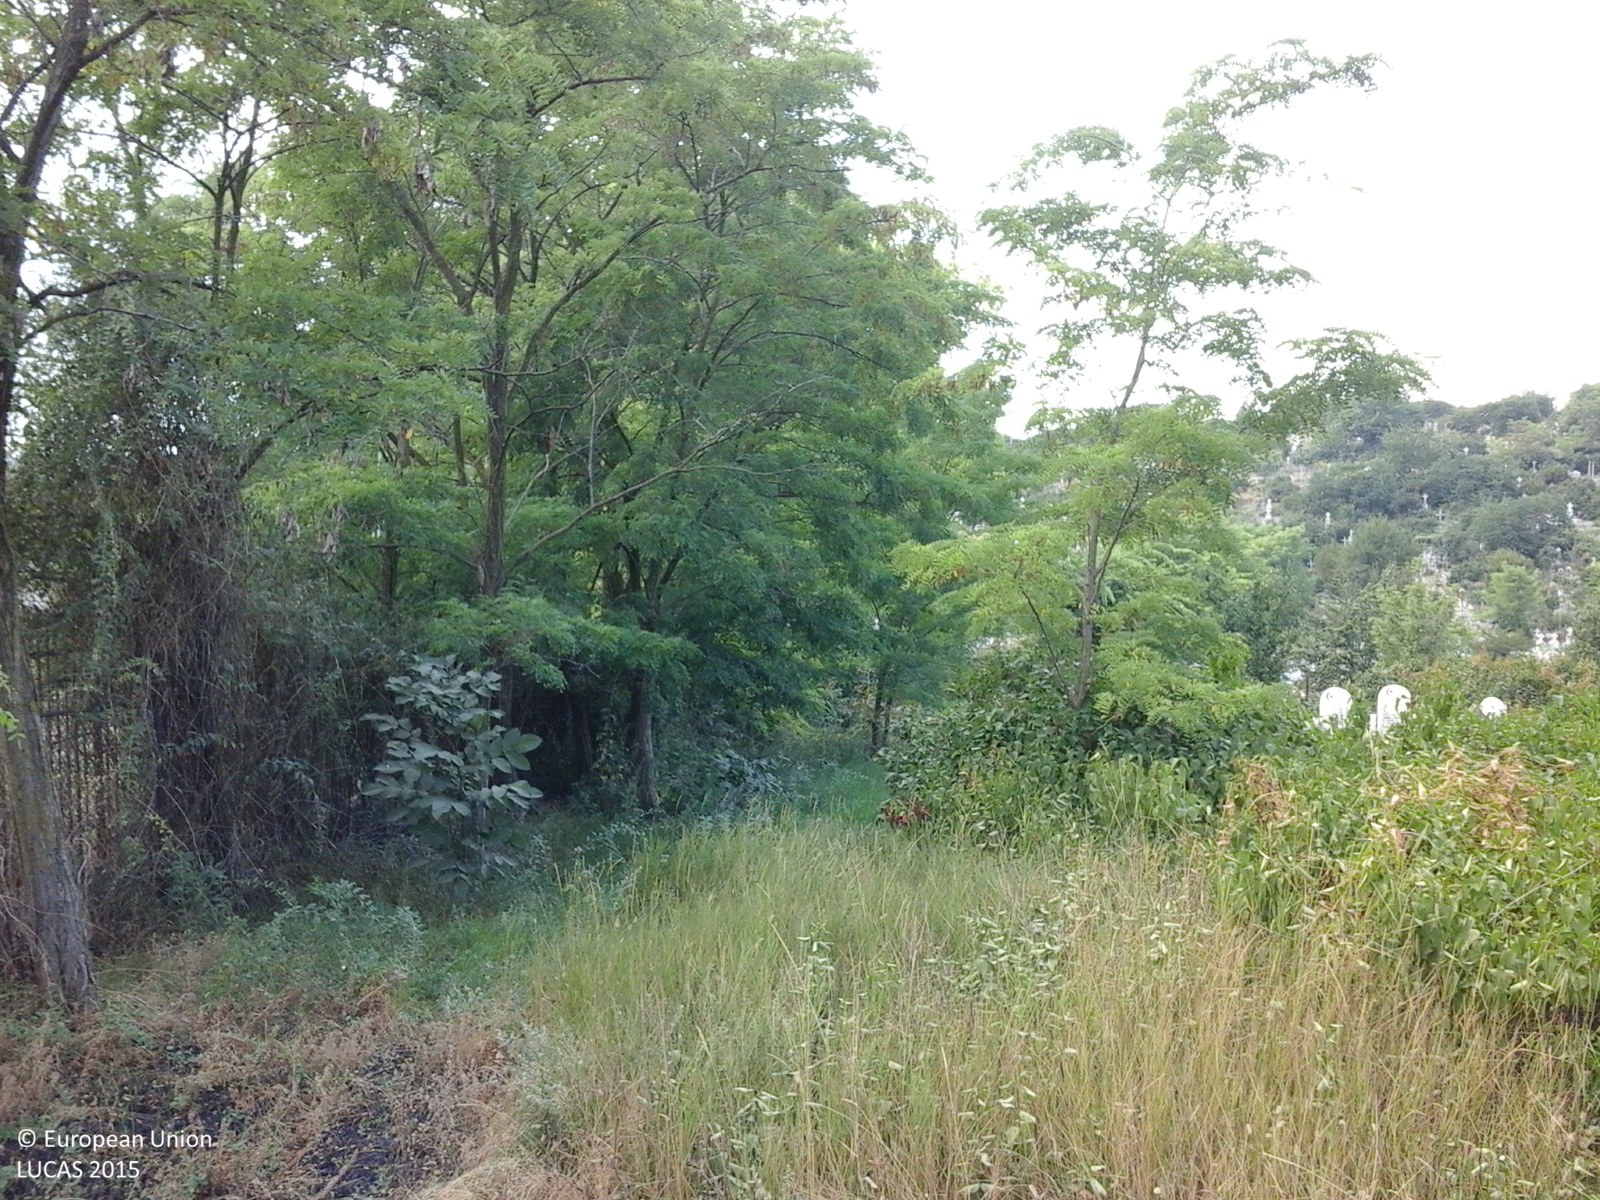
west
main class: Grassland
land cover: Spontaneously vegetated surfaces
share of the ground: > 75 %
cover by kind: herbaceous plants 100 %
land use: Community services
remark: Burnt area
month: July
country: RO
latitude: 45.1626
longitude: 28.8039
